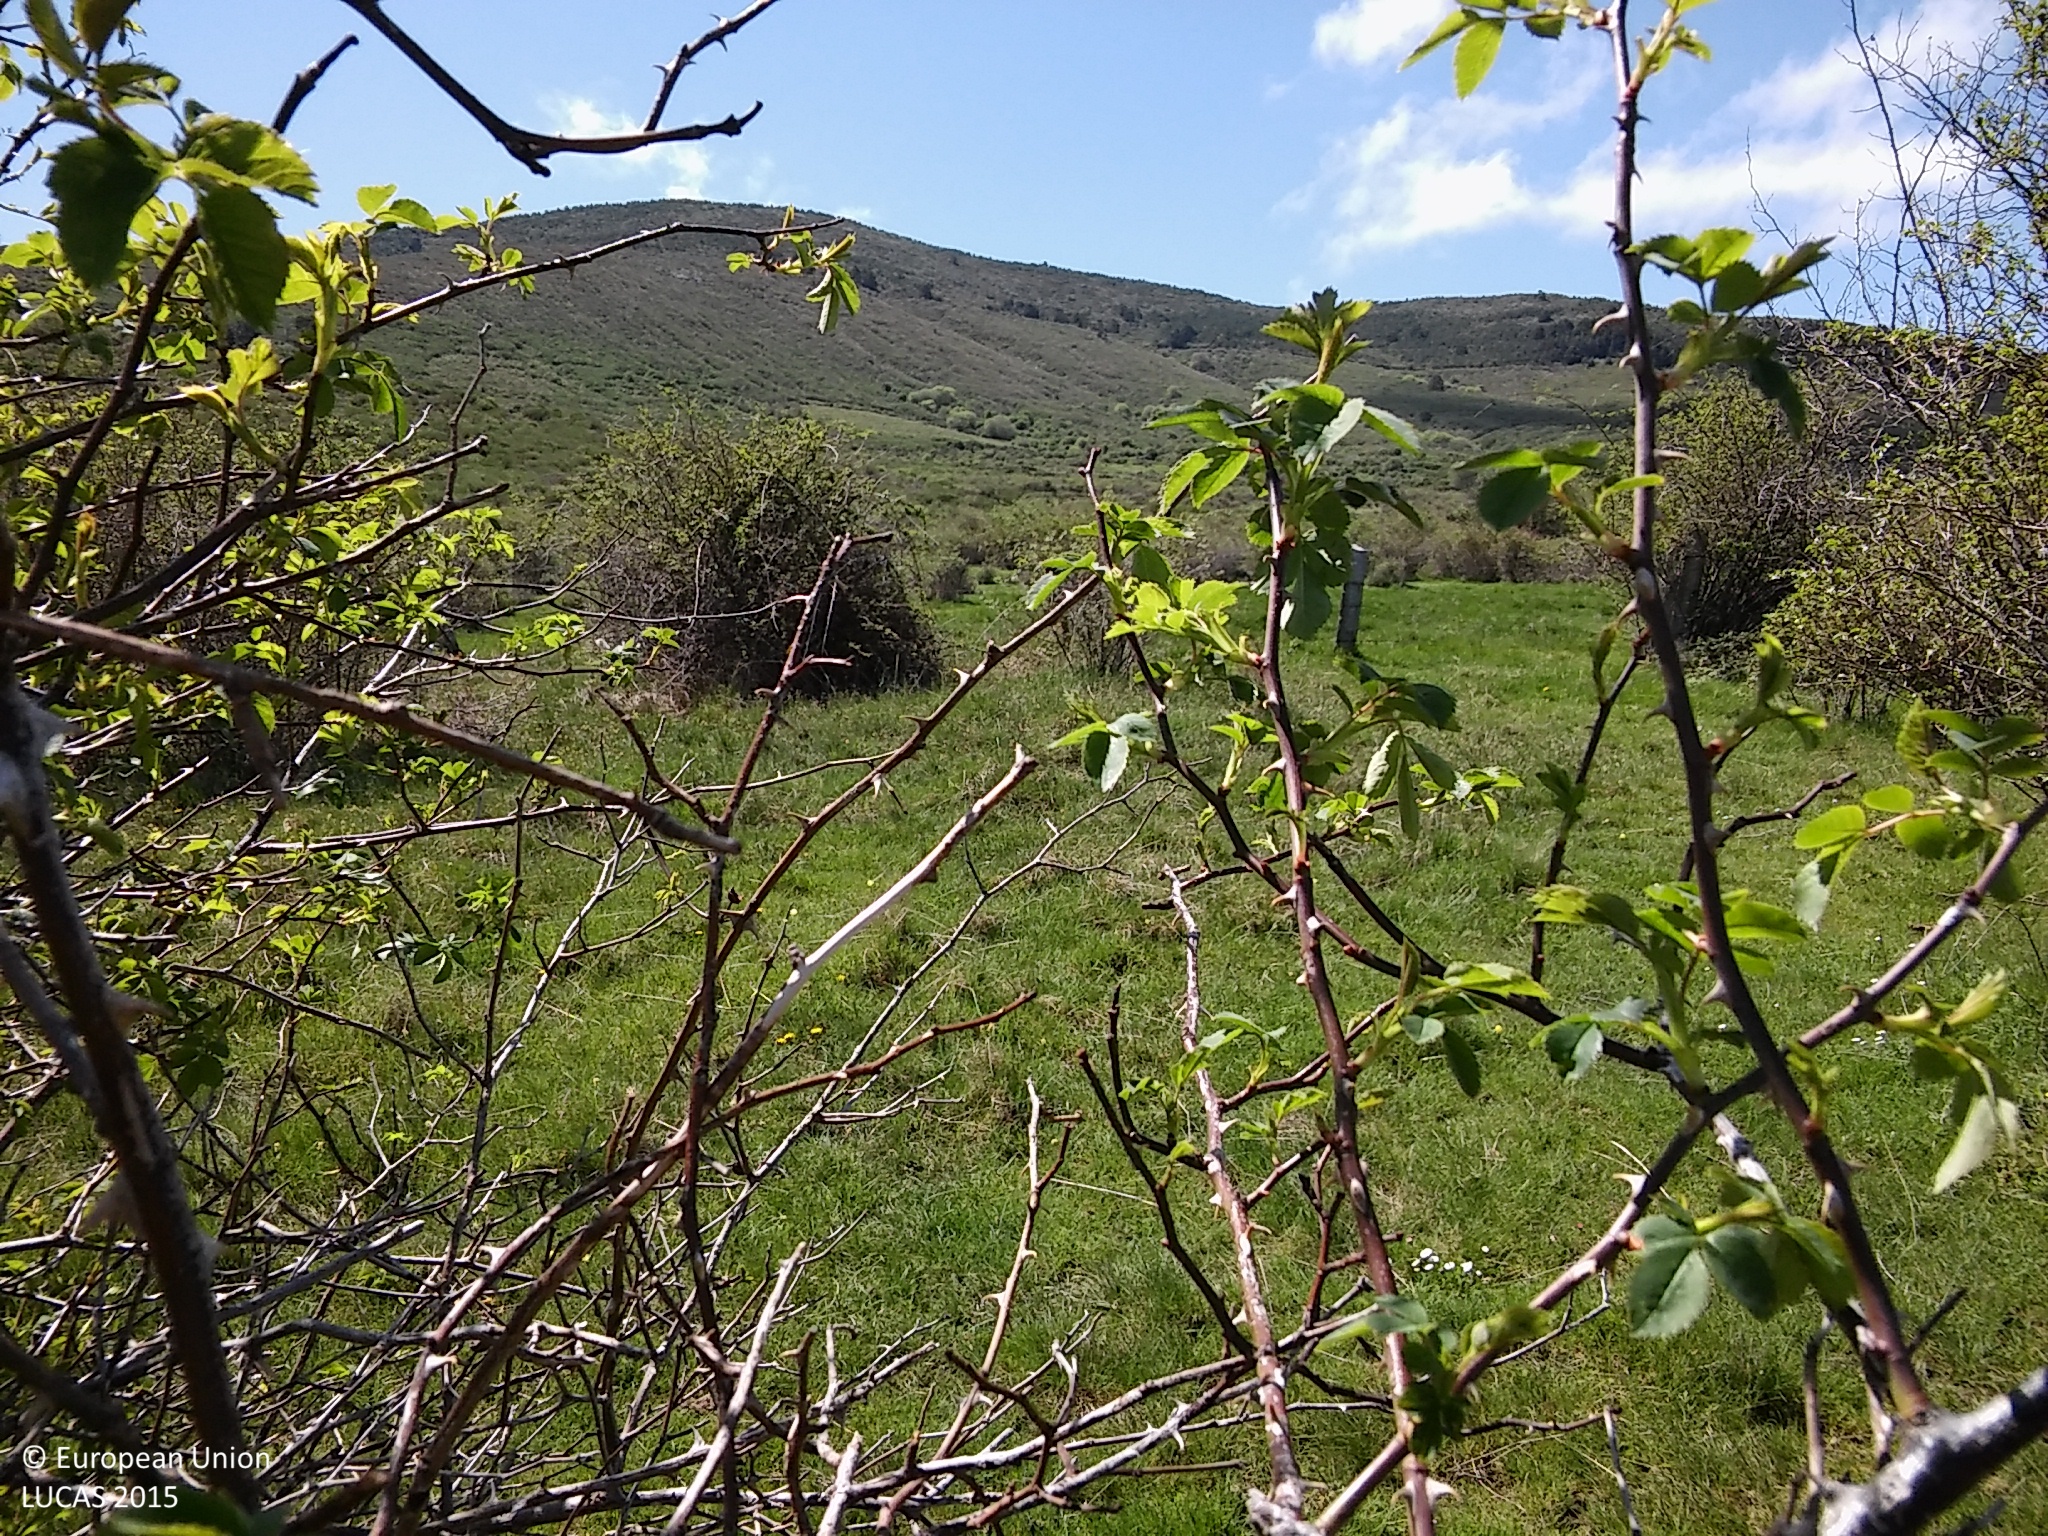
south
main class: Shrubland
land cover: Shrubland without tree cover
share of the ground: 10 - 25 %
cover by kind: herbaceous plants 60 %, shrubs 40 %
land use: Agriculture (excluding fallow land and kitchen gardens)
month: May
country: ES
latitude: 40.9853
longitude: -3.9668
